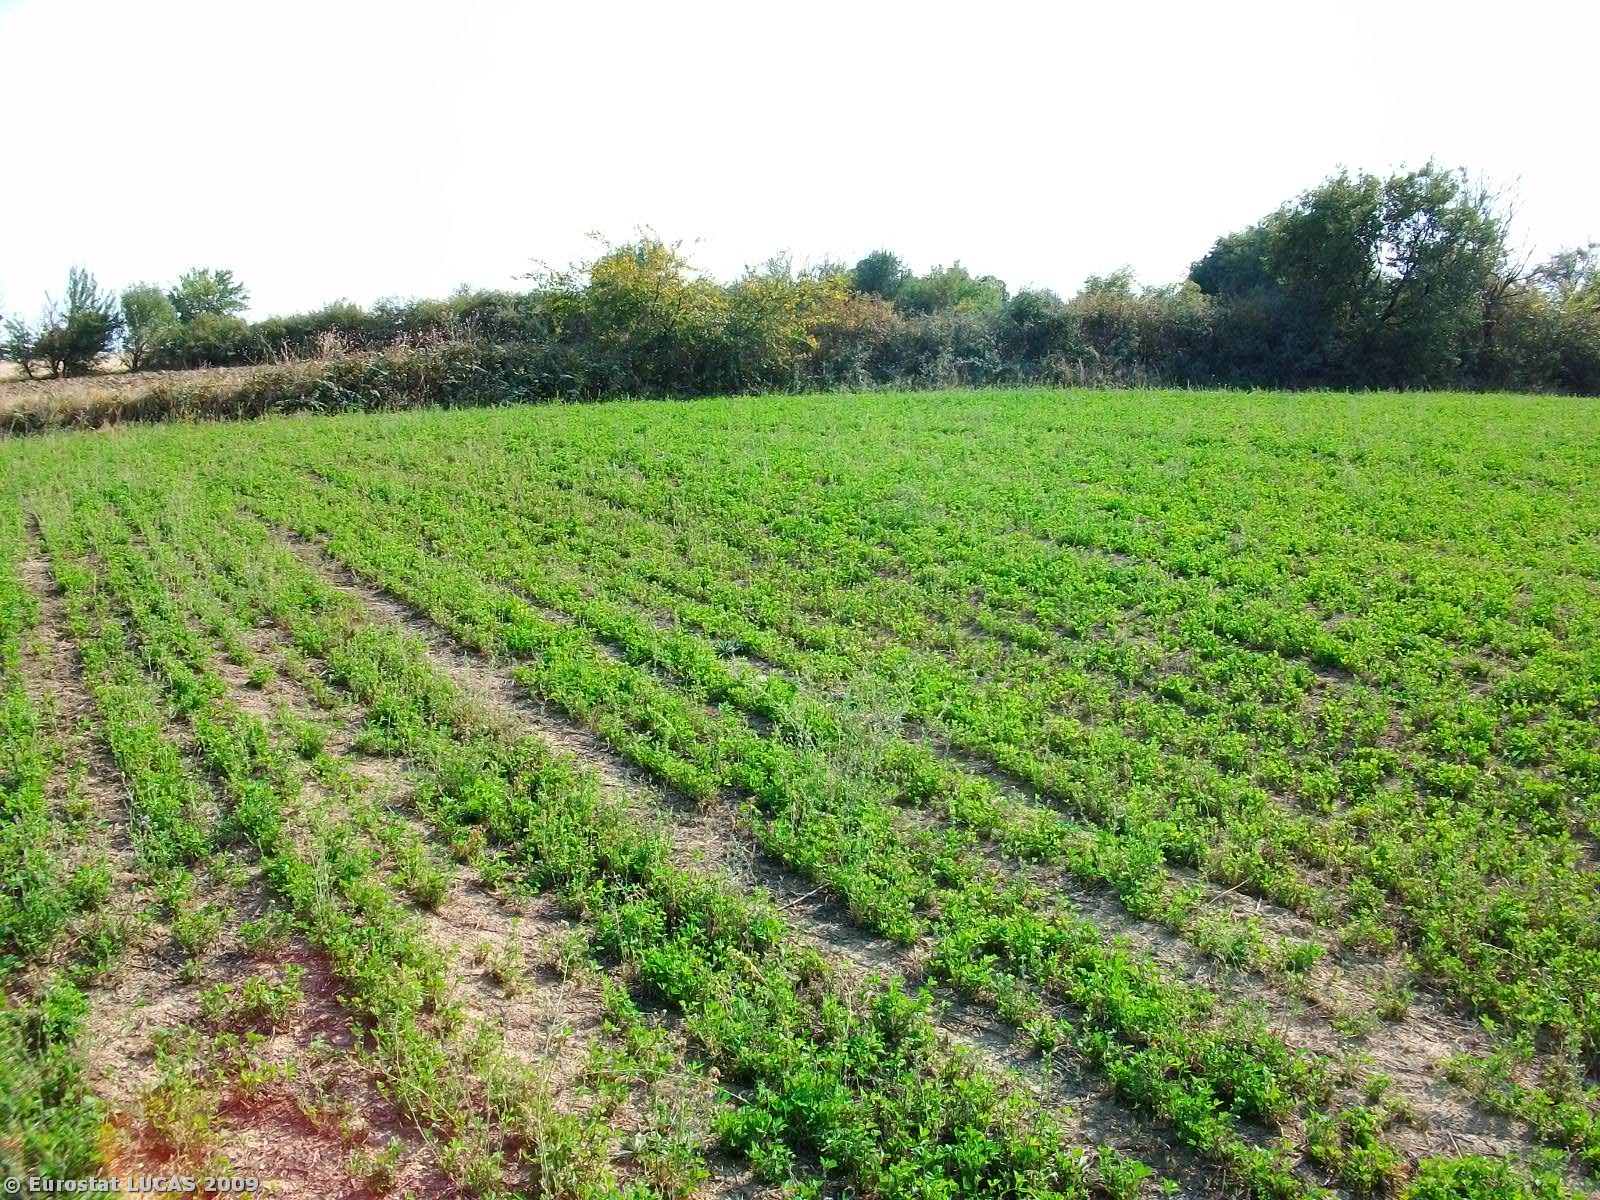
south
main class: Cropland
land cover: Lucerne
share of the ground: 50 - 75 %
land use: Agriculture (excluding fallow land and kitchen gardens)
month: September
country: GR
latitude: 41.0225
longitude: 26.2278
